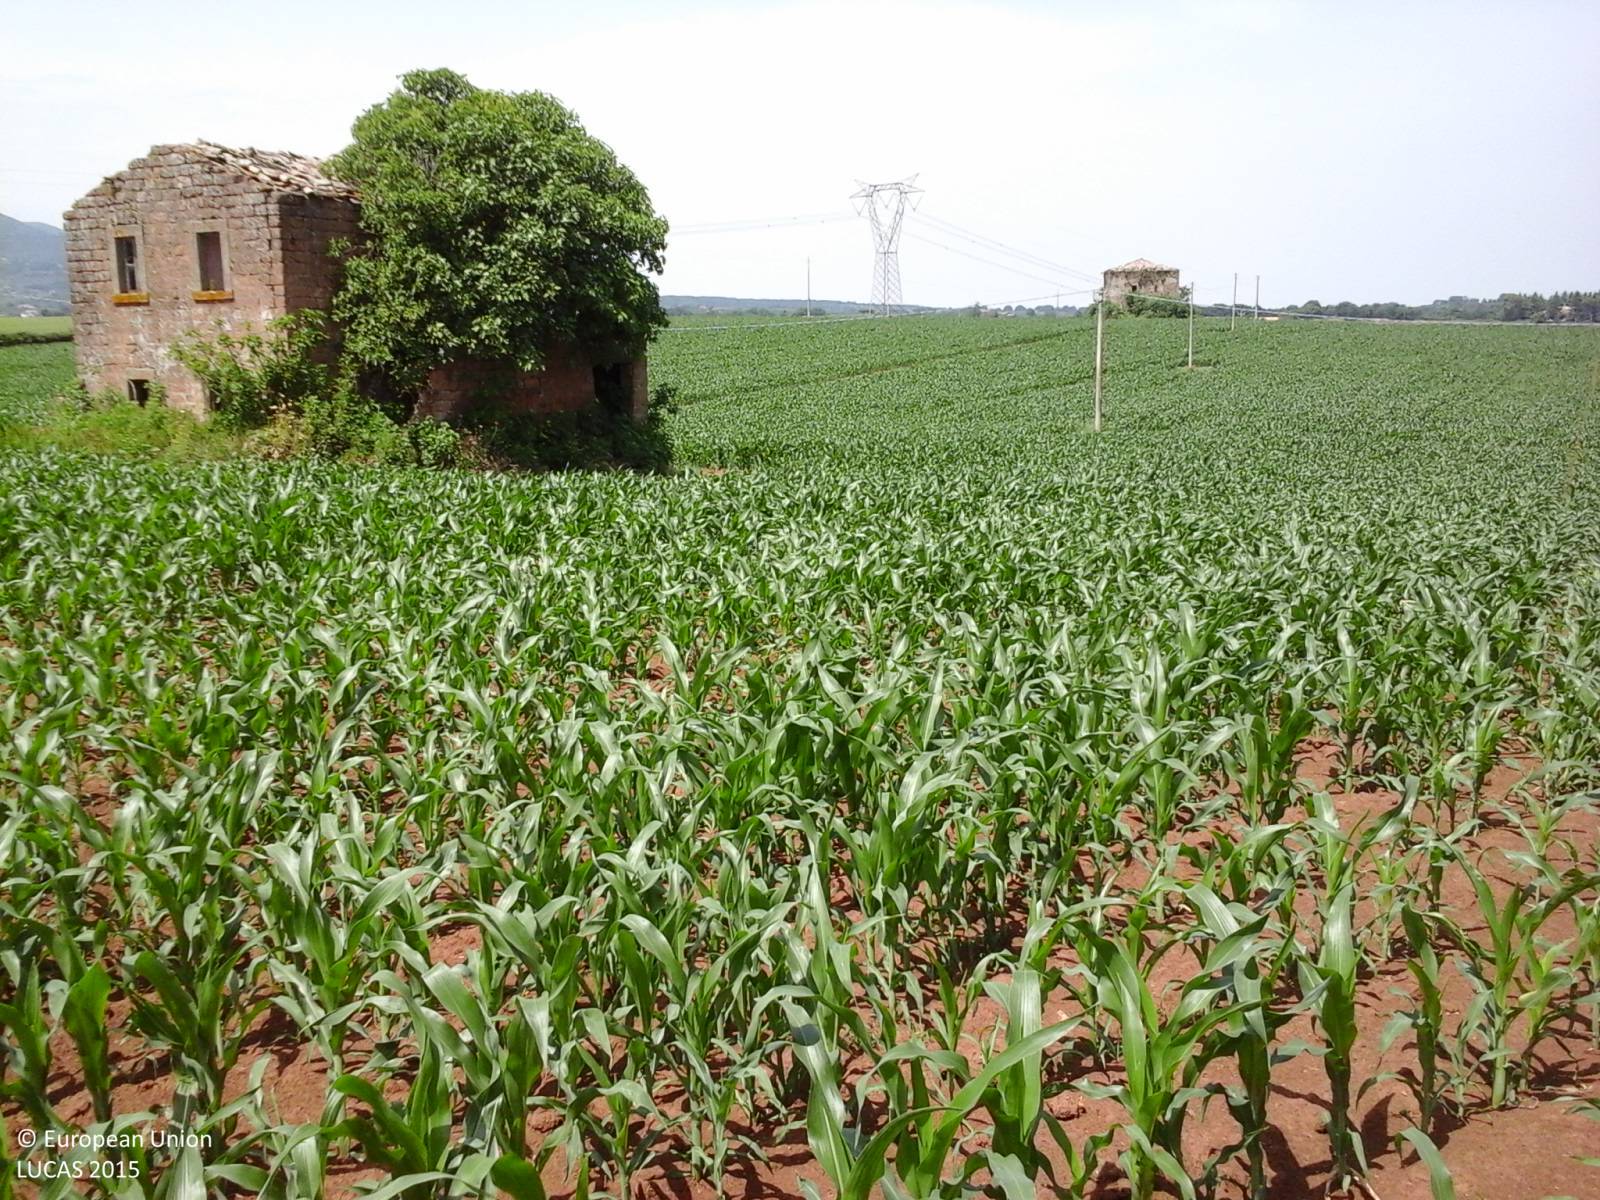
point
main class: Cropland
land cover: Maize
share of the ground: > 75 %
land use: Agriculture (excluding fallow land and kitchen gardens)
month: June
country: IT
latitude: 42.4480
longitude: 12.2660
